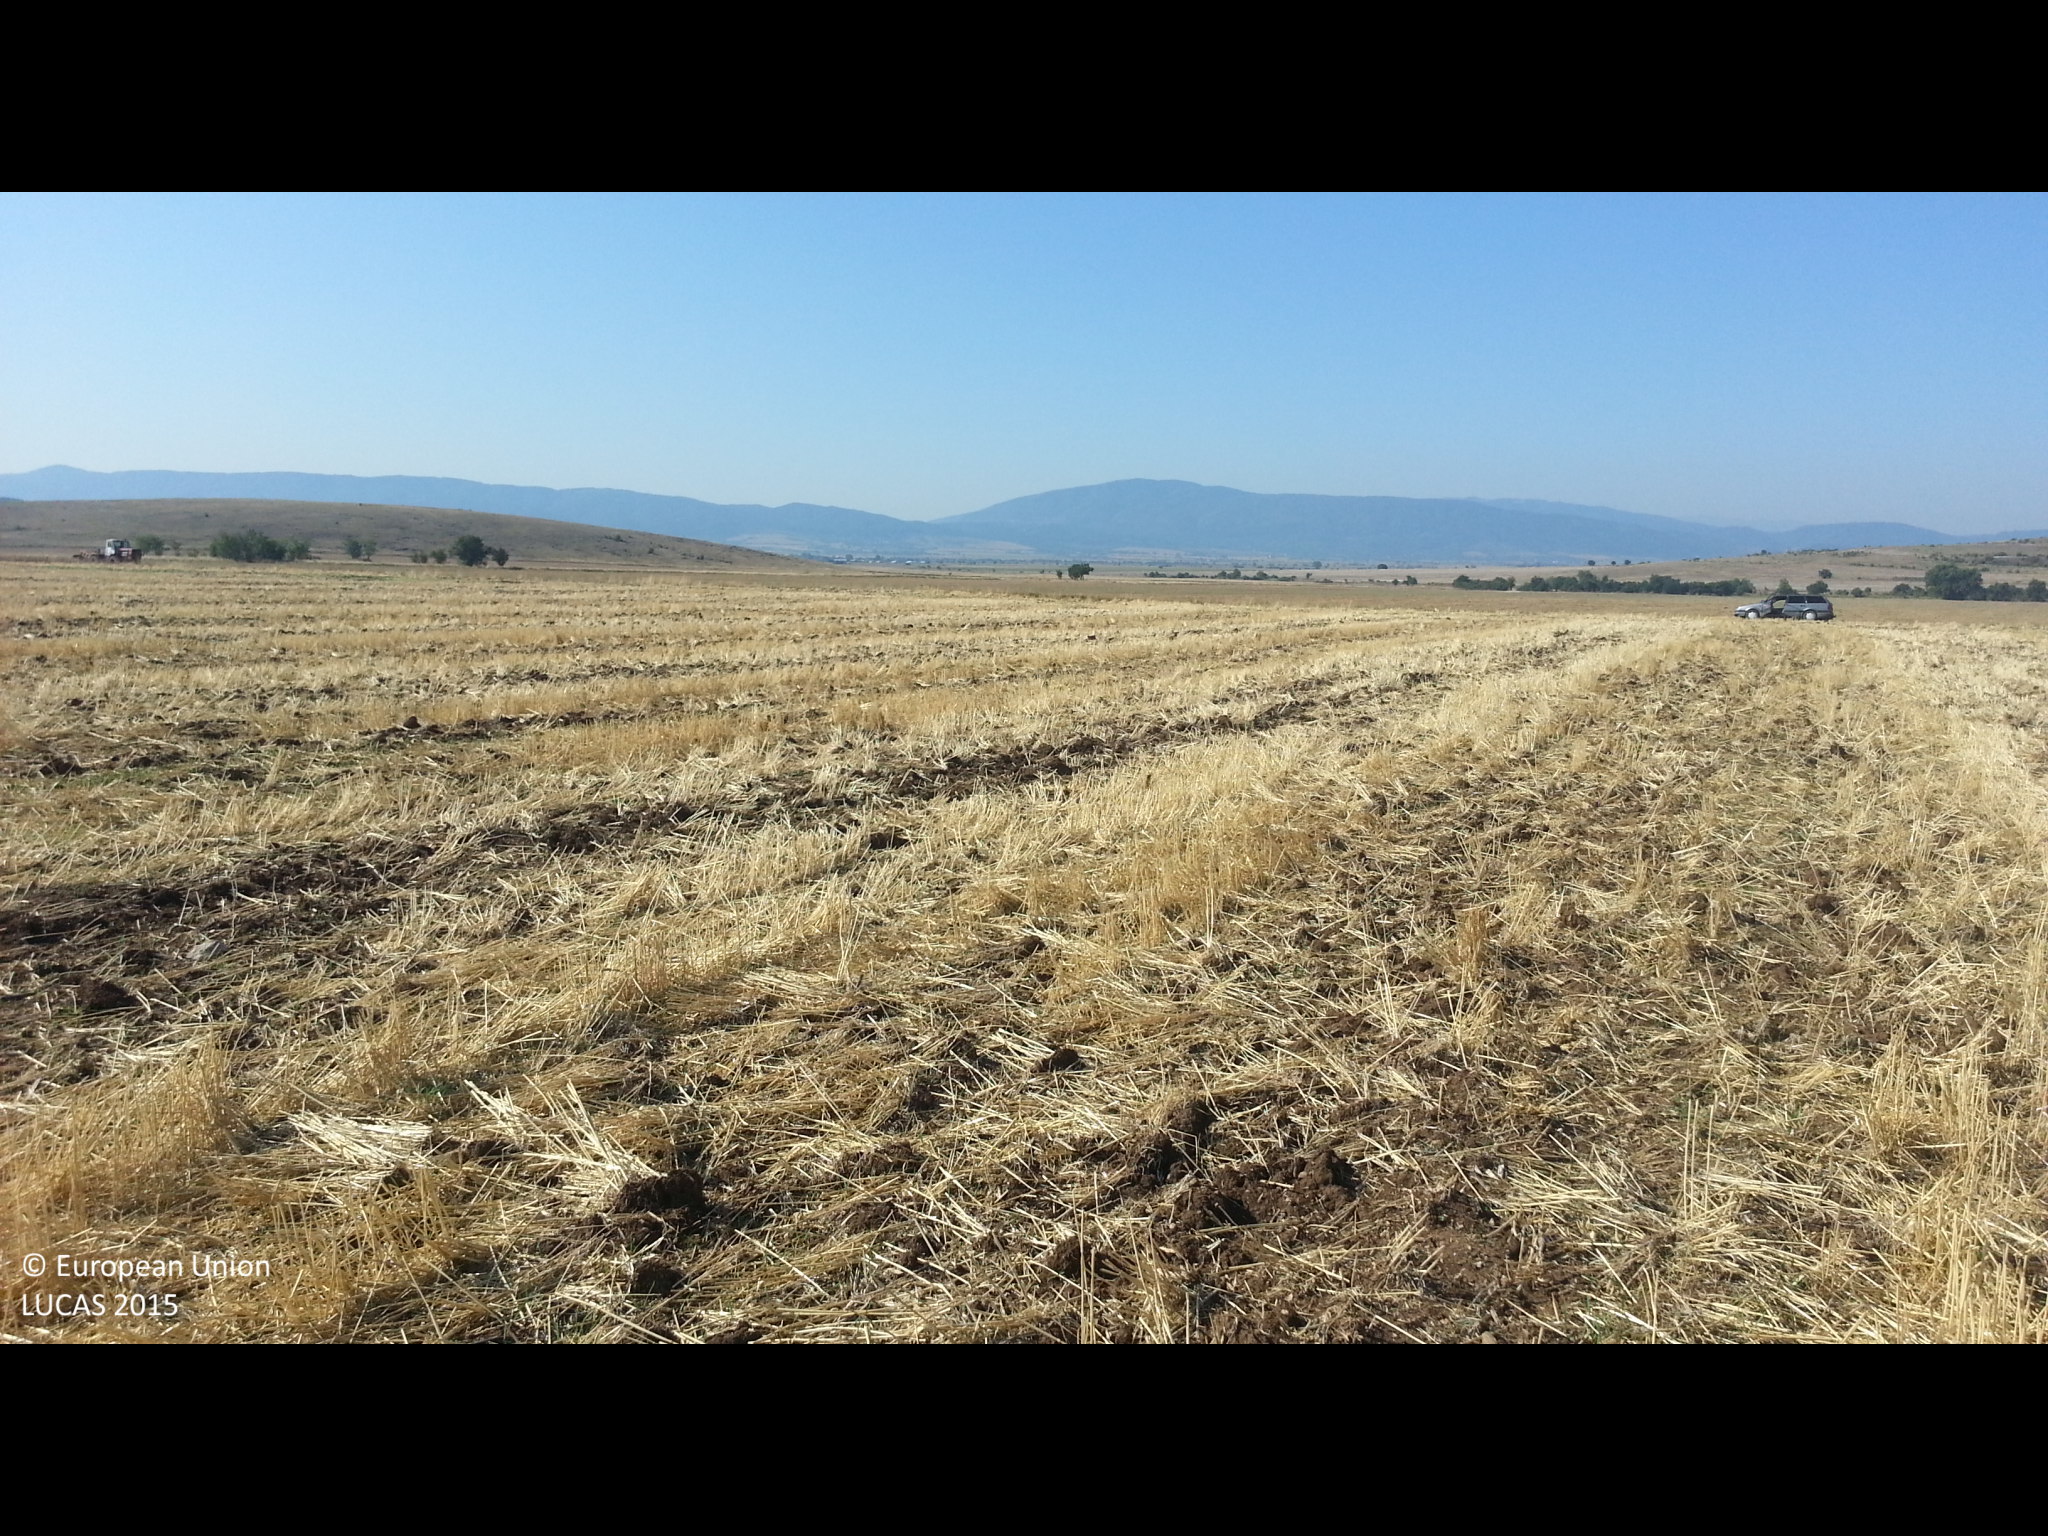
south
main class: Cropland
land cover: Common wheat
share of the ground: 25 - 50 %
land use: Agriculture (excluding fallow land and kitchen gardens)
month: August
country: BG
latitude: 42.5048
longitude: 23.0129
